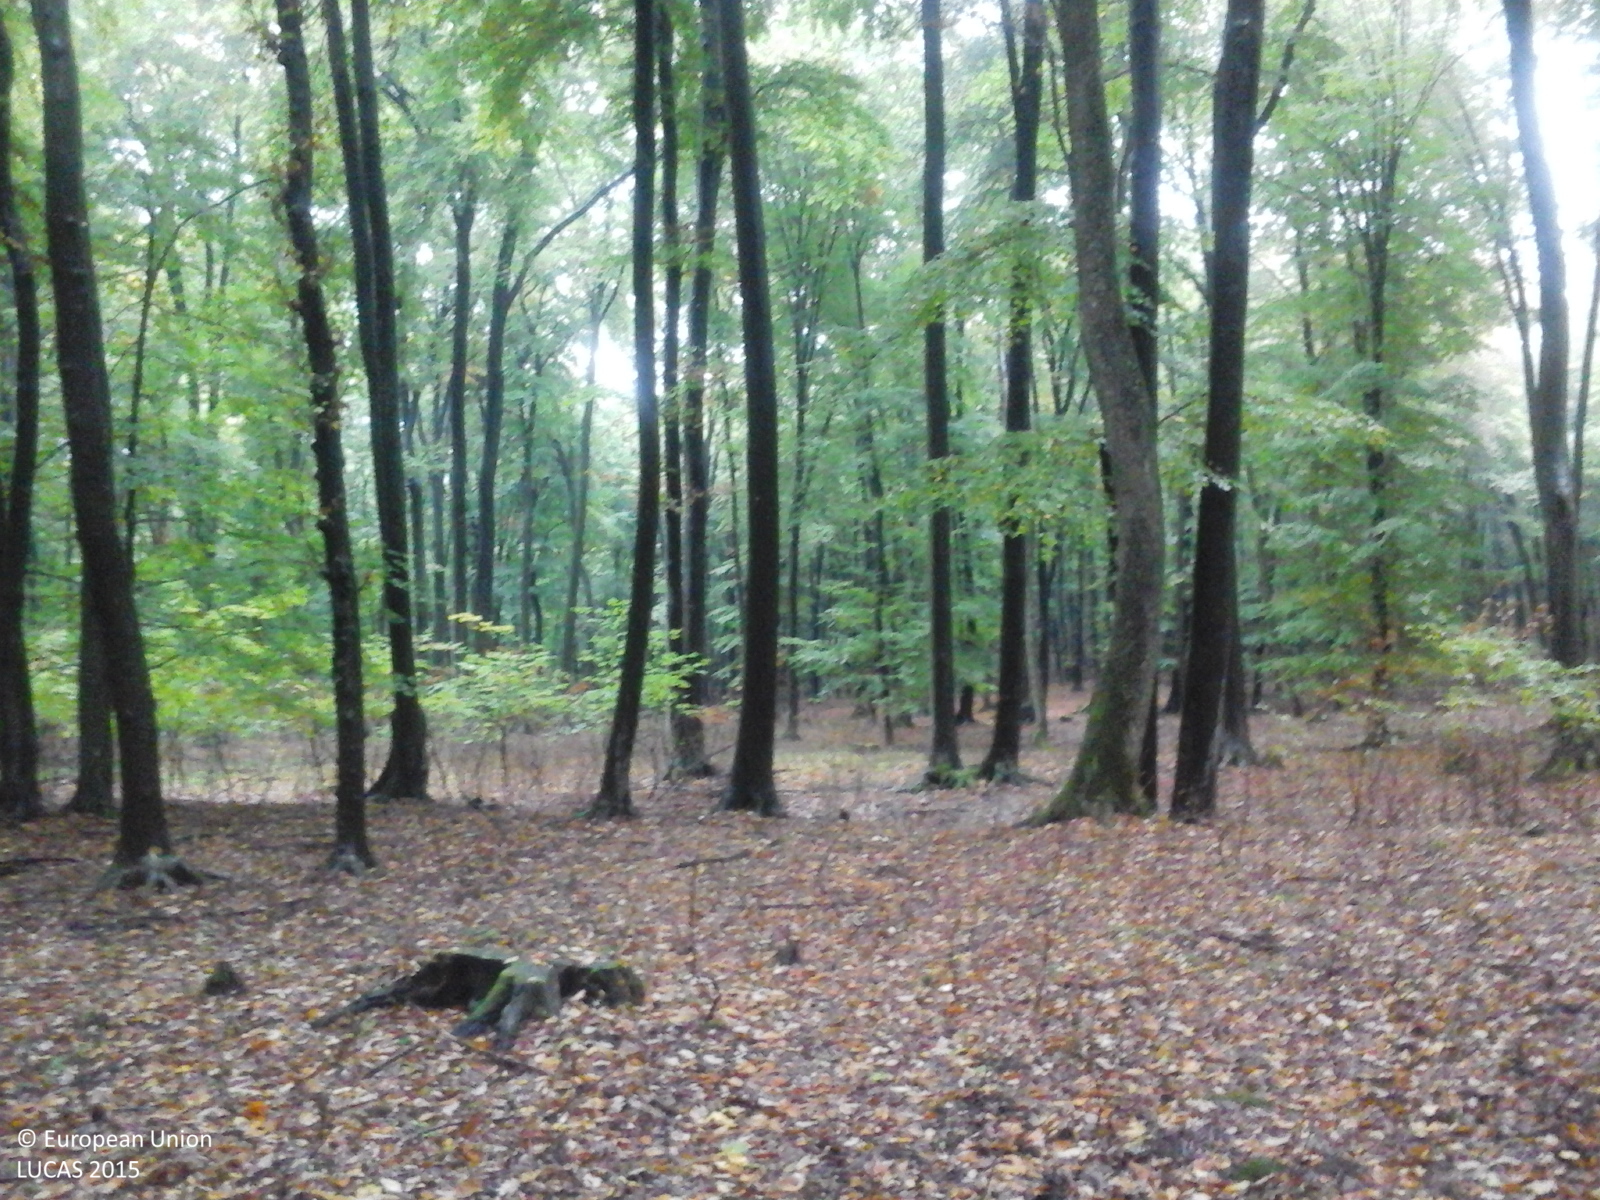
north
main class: Woodland
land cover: Broadleaved woodland
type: beech forest
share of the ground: > 75 %
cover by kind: broadleaved forest trees 100 %
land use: Forestry
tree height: > 5 m
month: October
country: RO
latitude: 46.0559
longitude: 24.4690
